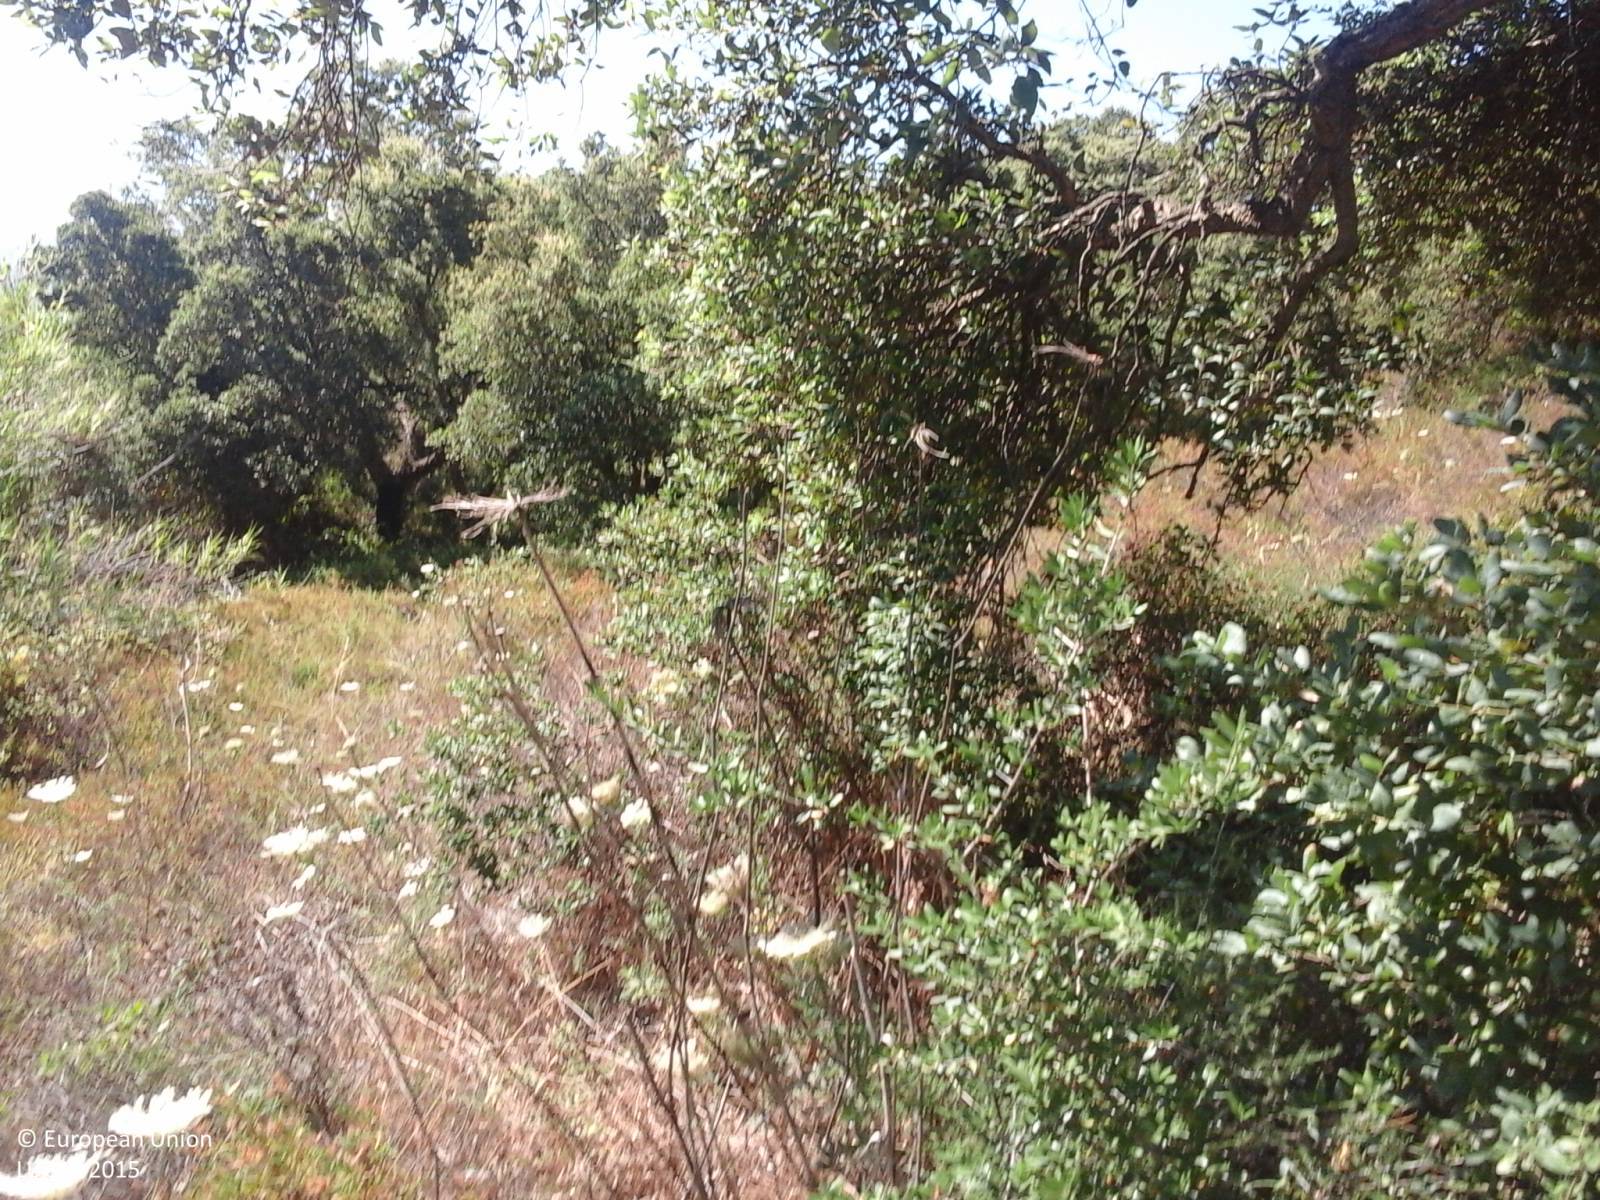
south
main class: Woodland
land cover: Broadleaved woodland
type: broadleaved evergreen forest
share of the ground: > 75 %
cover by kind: broadleaved forest trees 80 %, herbaceous plants 15 %, shrubs 5 %
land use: Semi-natural and natural areas not in use
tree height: > 5 m
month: July
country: IT
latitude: 39.5326
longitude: 8.5773
